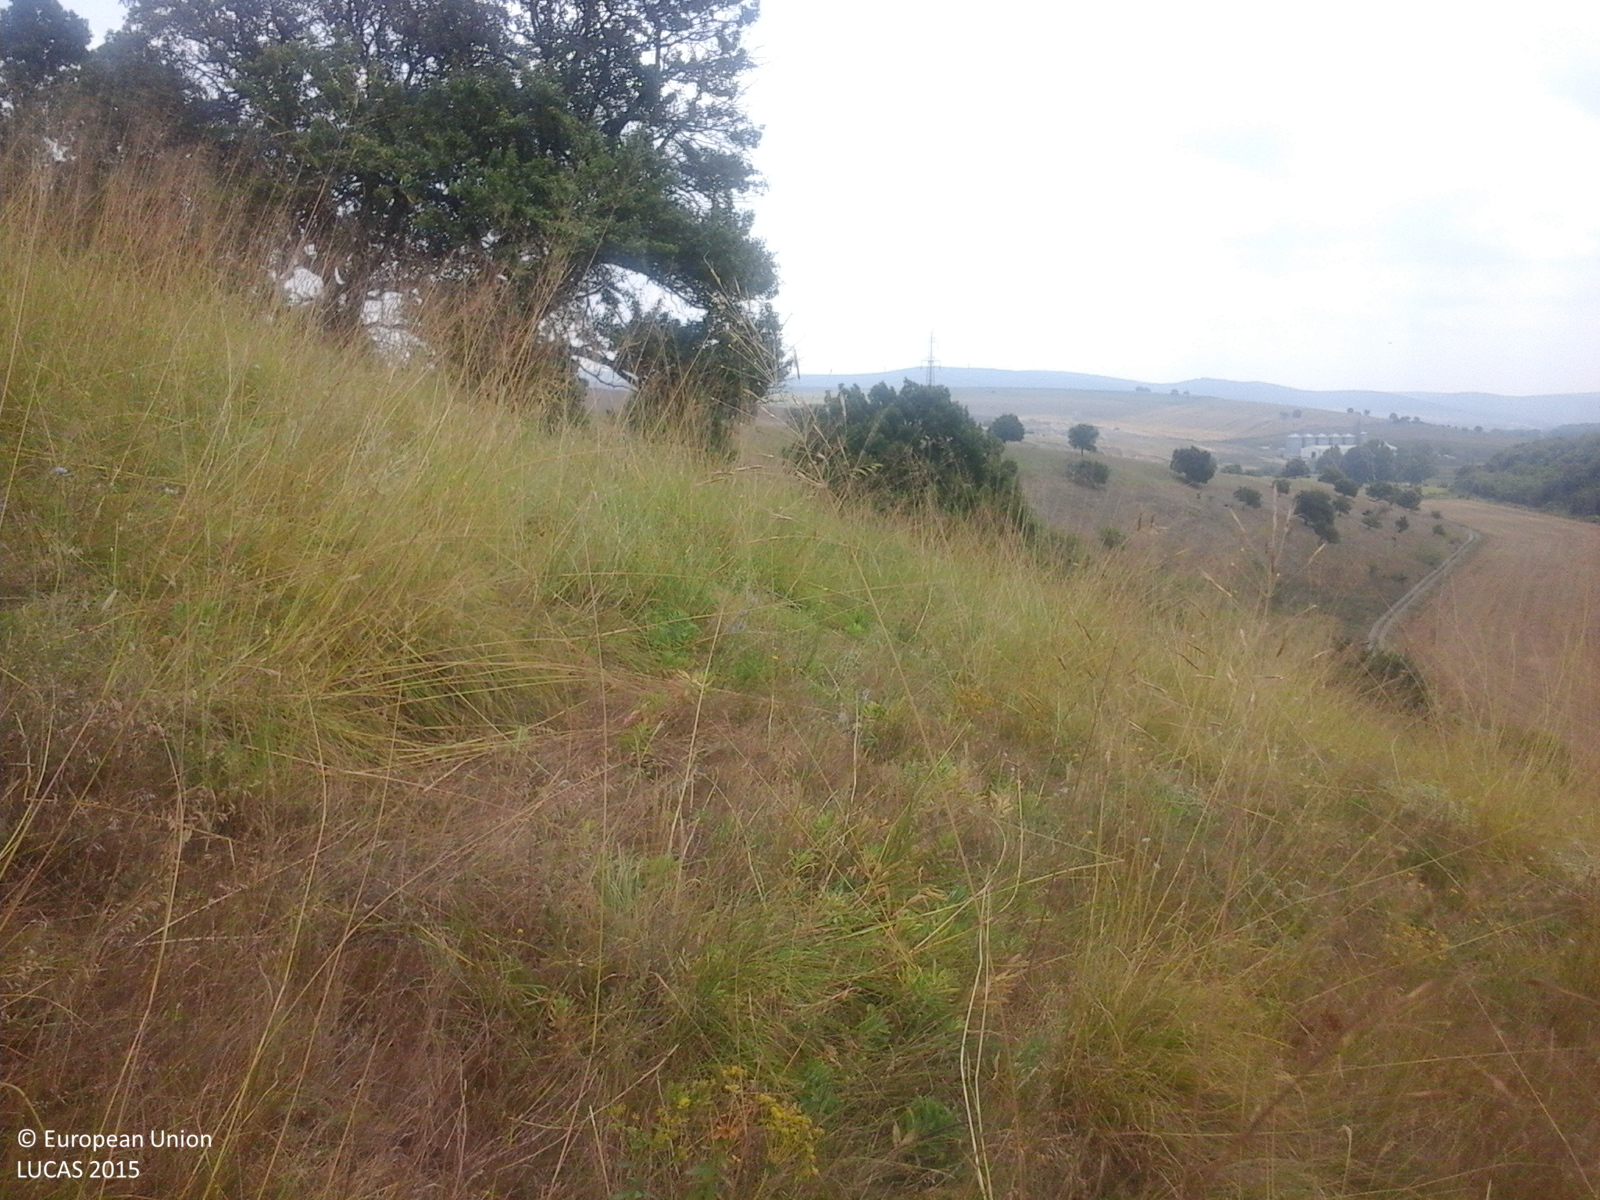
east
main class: Grassland
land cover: Grassland with sparse tree/shrub cover
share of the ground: > 75 %
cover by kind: herbaceous plants 85 %, shrubs 10 %, broadleaved forest trees 5 %
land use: Agriculture (excluding fallow land and kitchen gardens)
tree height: > 5 m
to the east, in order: Grassland with sparse tree/shrub cover
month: July
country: RO
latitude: 44.9335
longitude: 28.4360
